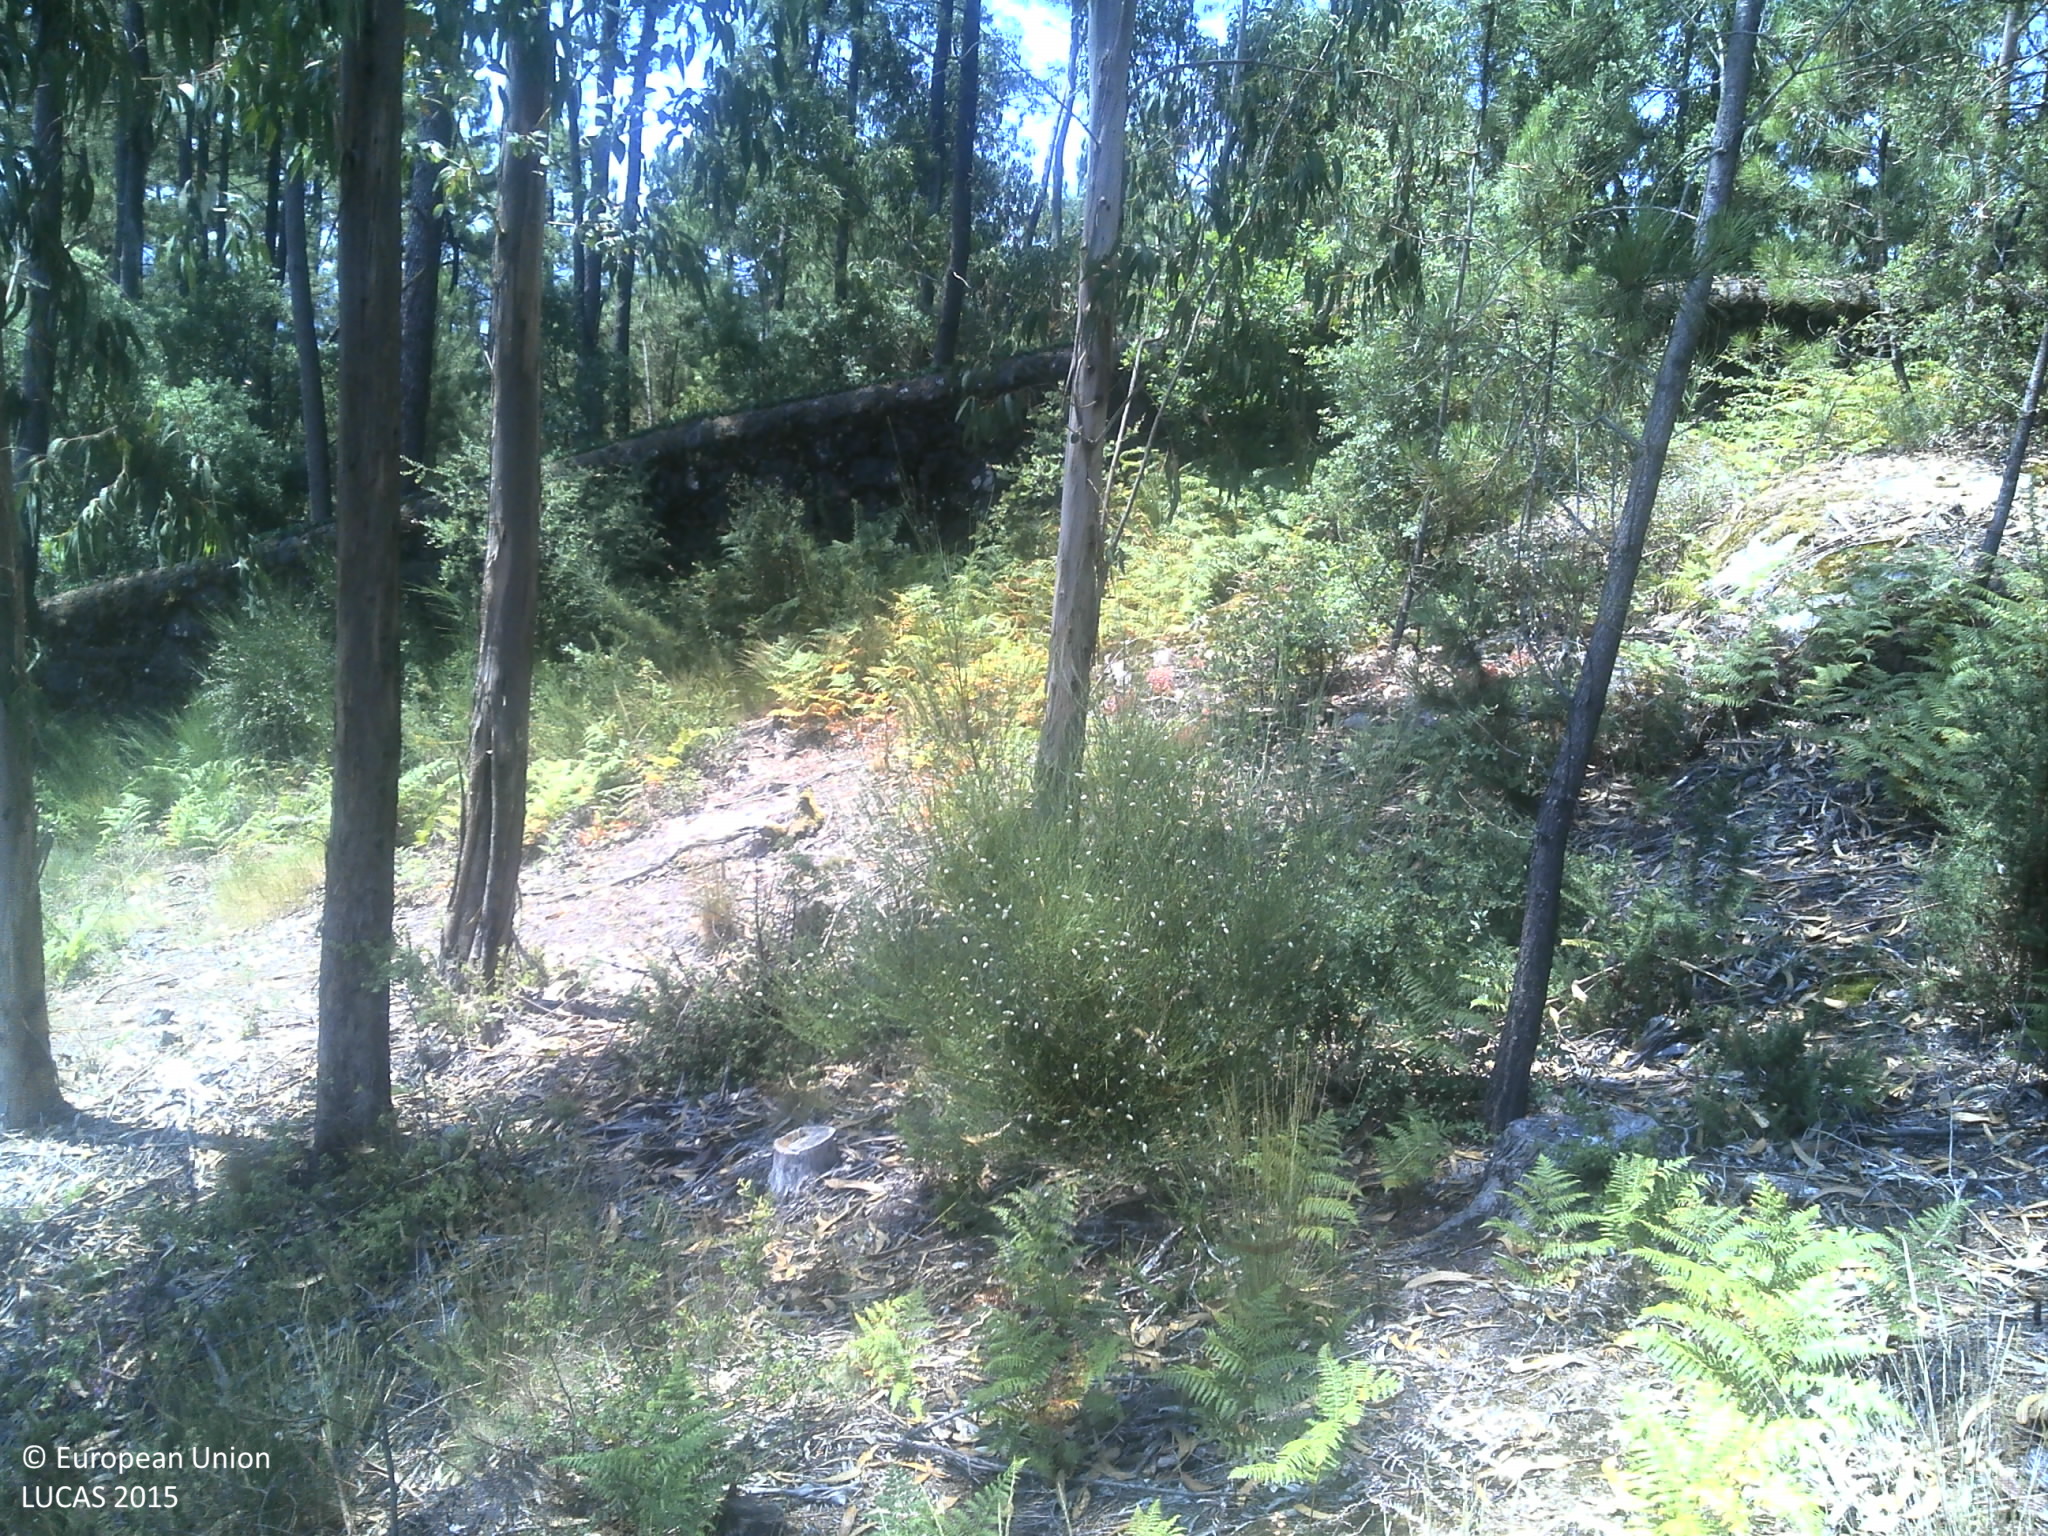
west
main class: Shrubland
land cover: Shrubland with sparse tree cover
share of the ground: 50 - 75 %
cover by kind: shrubs 60 %, unconsolidated bare surface 25 %, consolidated bare surface 10 %, broadleaved forest trees 5 %
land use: Forestry
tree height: < 5 m
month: June
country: PT
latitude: 41.5840
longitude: -8.5711
